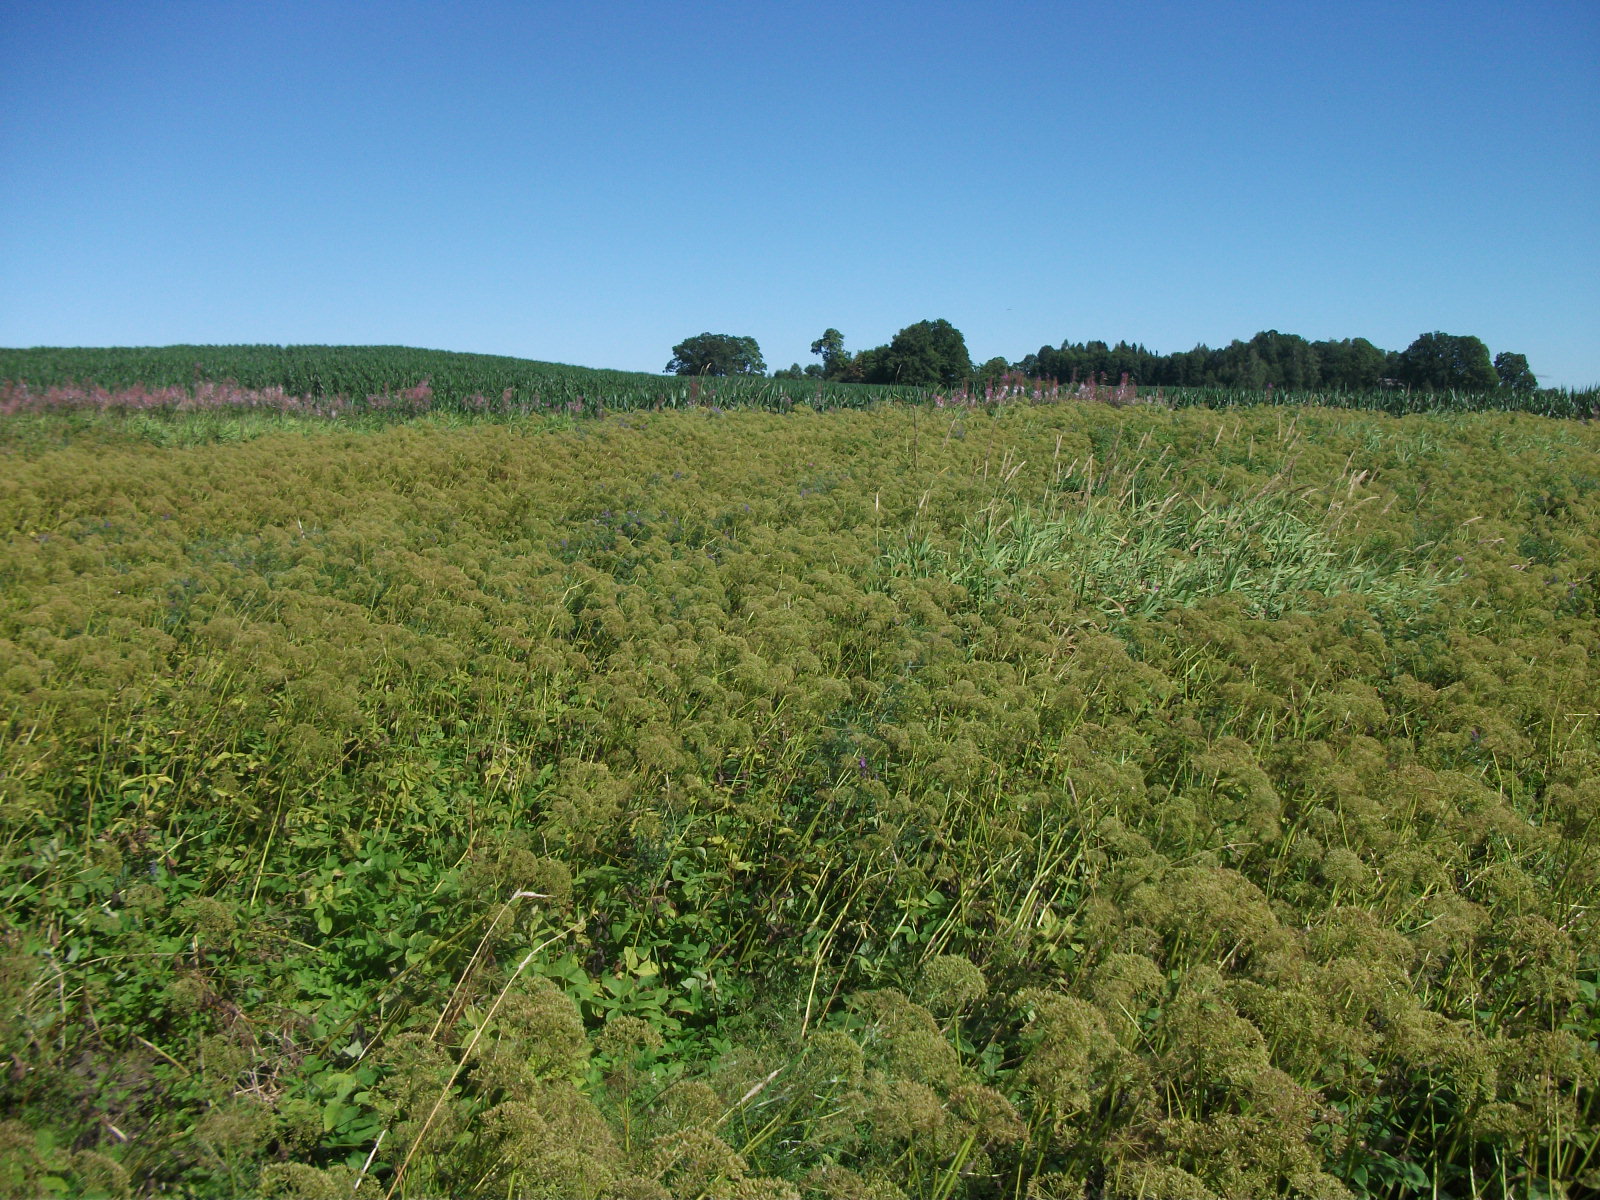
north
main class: Grassland
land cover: Spontaneously vegetated surfaces
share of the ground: > 75 %
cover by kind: herbaceous plants 100 %
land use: Abandoned areas
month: August
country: LV
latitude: 57.0265
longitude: 26.4705
